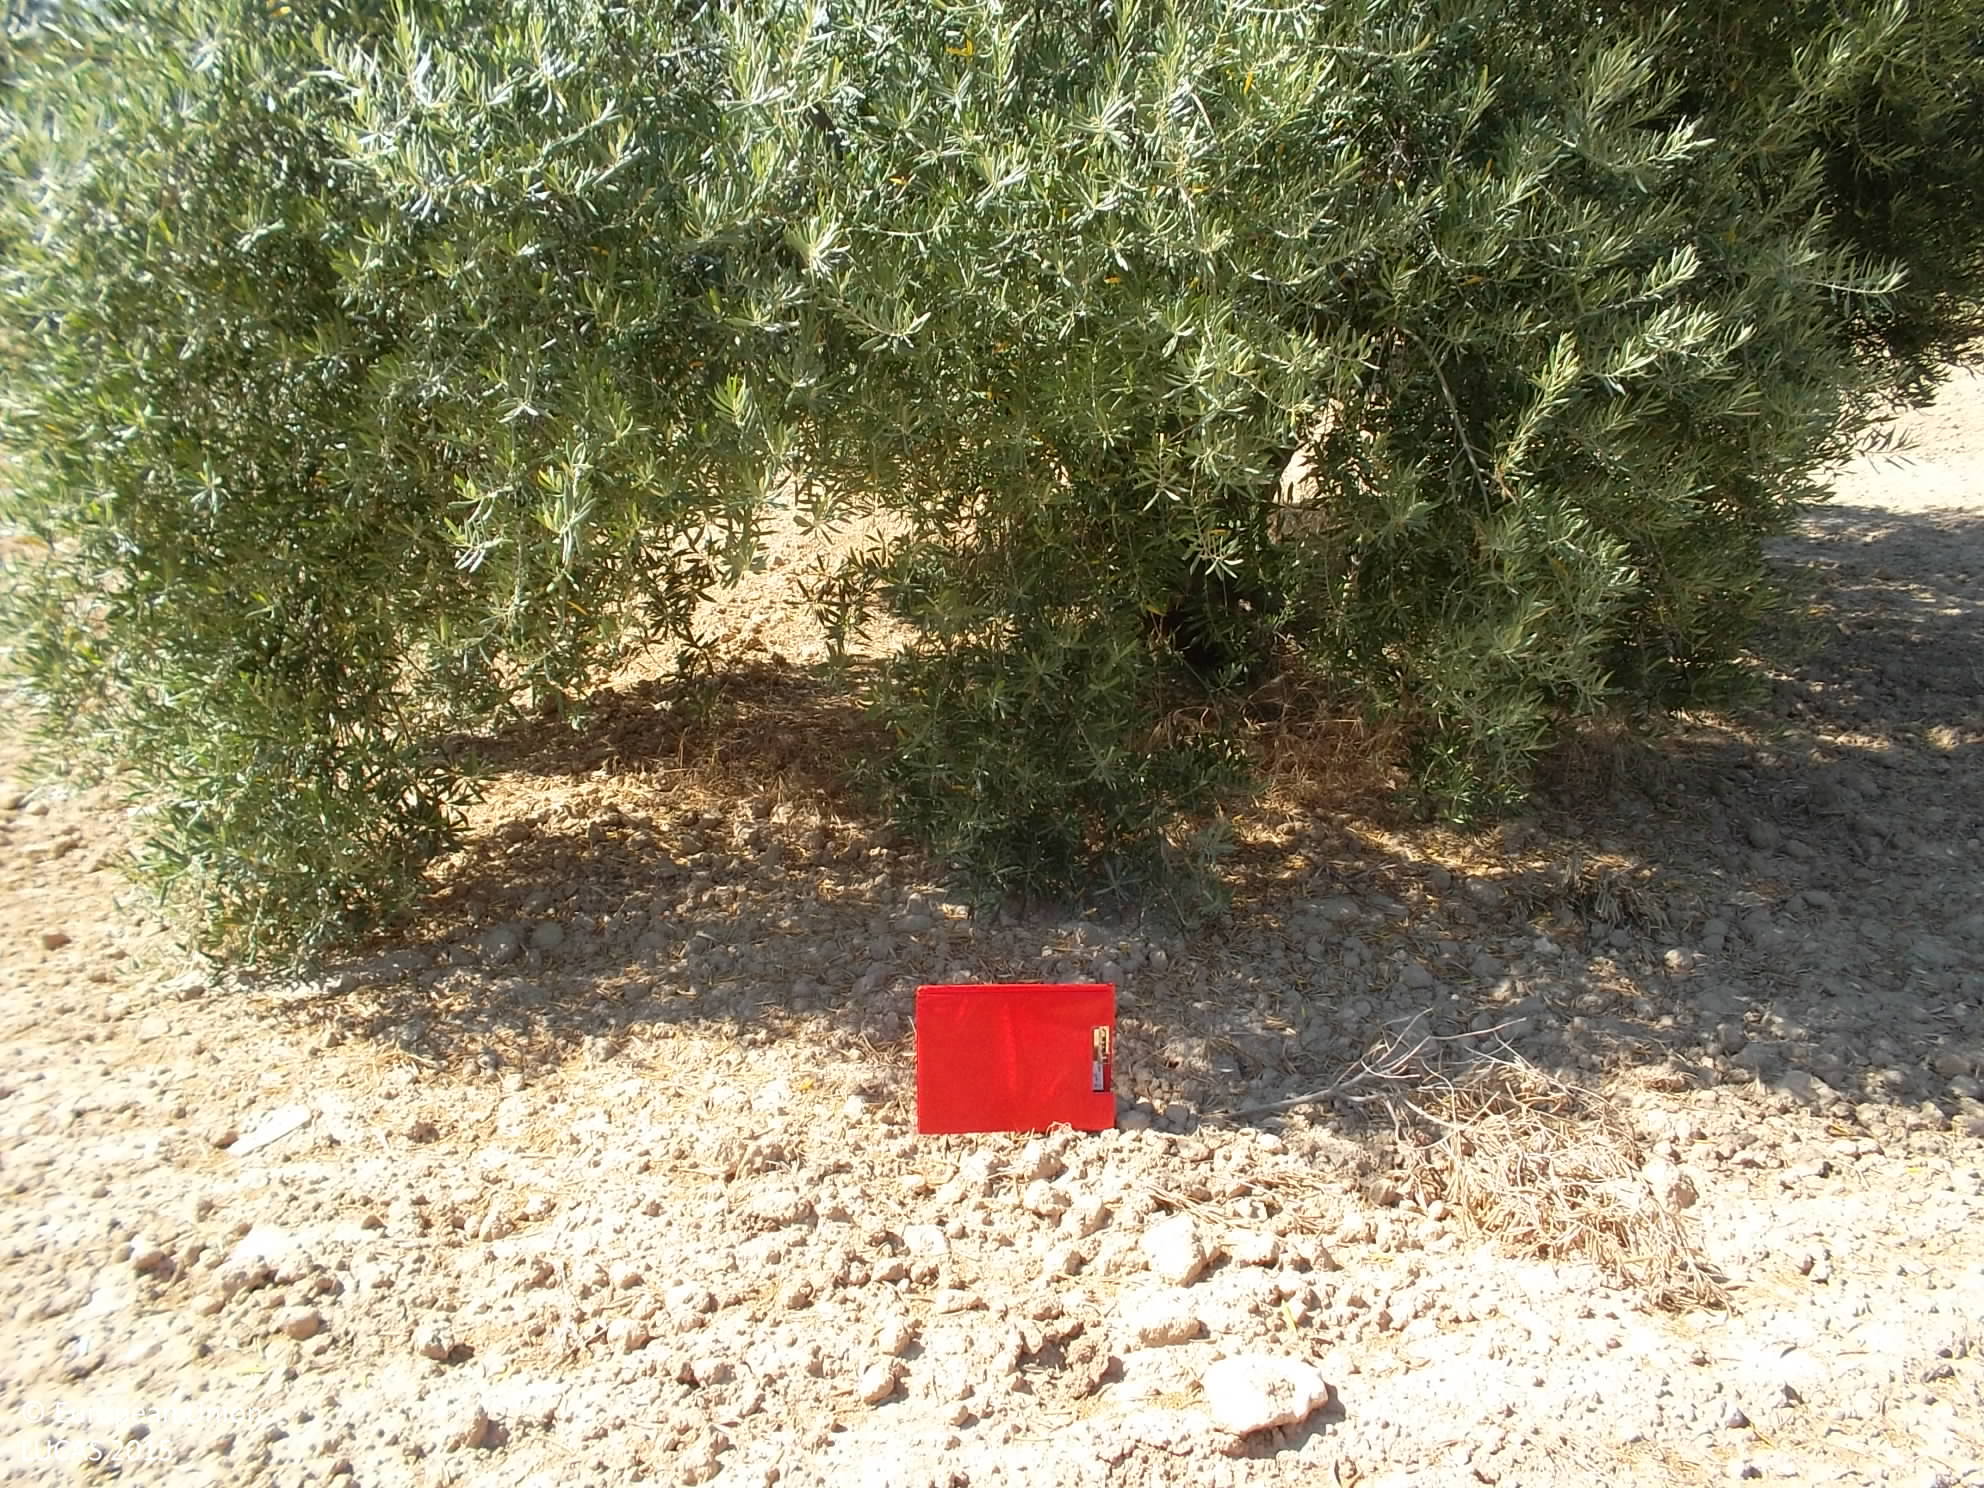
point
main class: Cropland
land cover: Olive groves
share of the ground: 25 - 50 %
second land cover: Other bare soil
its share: > 75 %
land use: Agriculture (excluding fallow land and kitchen gardens)
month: June
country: ES
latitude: 37.8507
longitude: -3.3283
